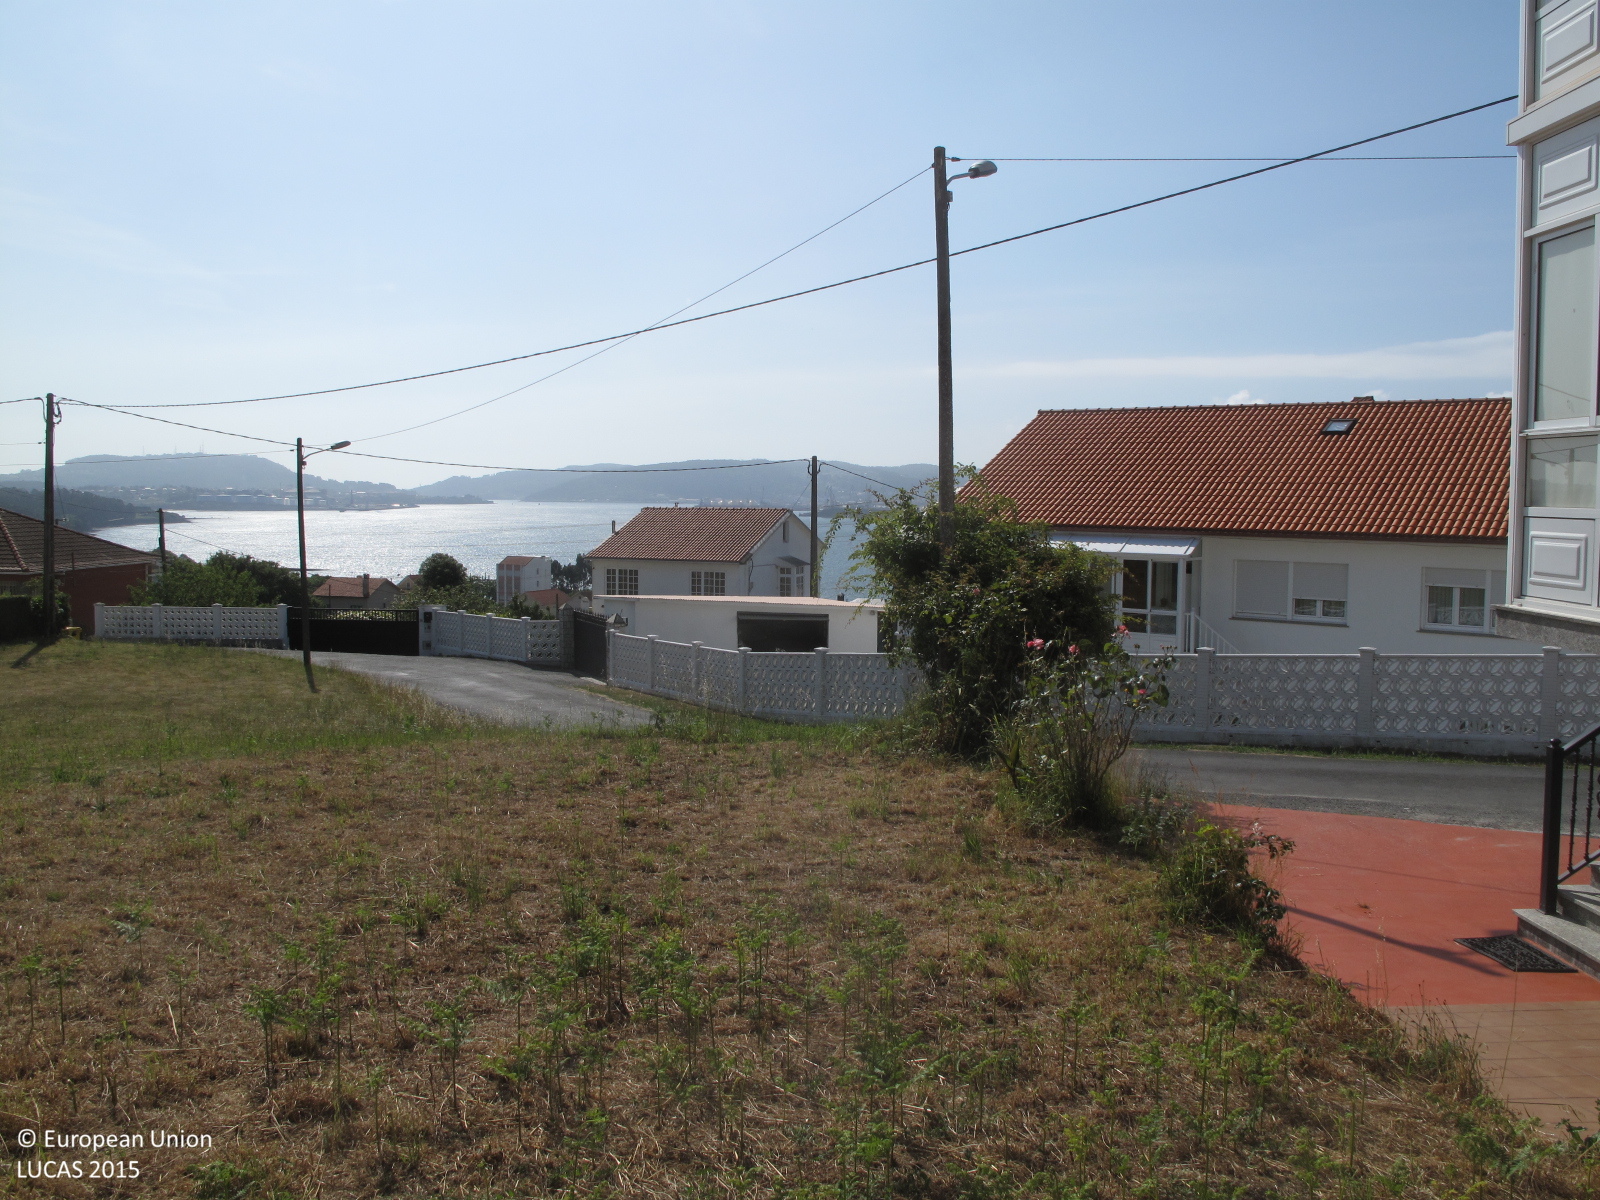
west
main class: Grassland
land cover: Grassland without tree/shrub cover
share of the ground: > 75 %
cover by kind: herbaceous plants 90 %, shrubs 5 %, unconsolidated bare surface 5 %
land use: Agriculture (excluding fallow land and kitchen gardens)
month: July
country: ES
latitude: 43.4653
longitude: -8.1845
